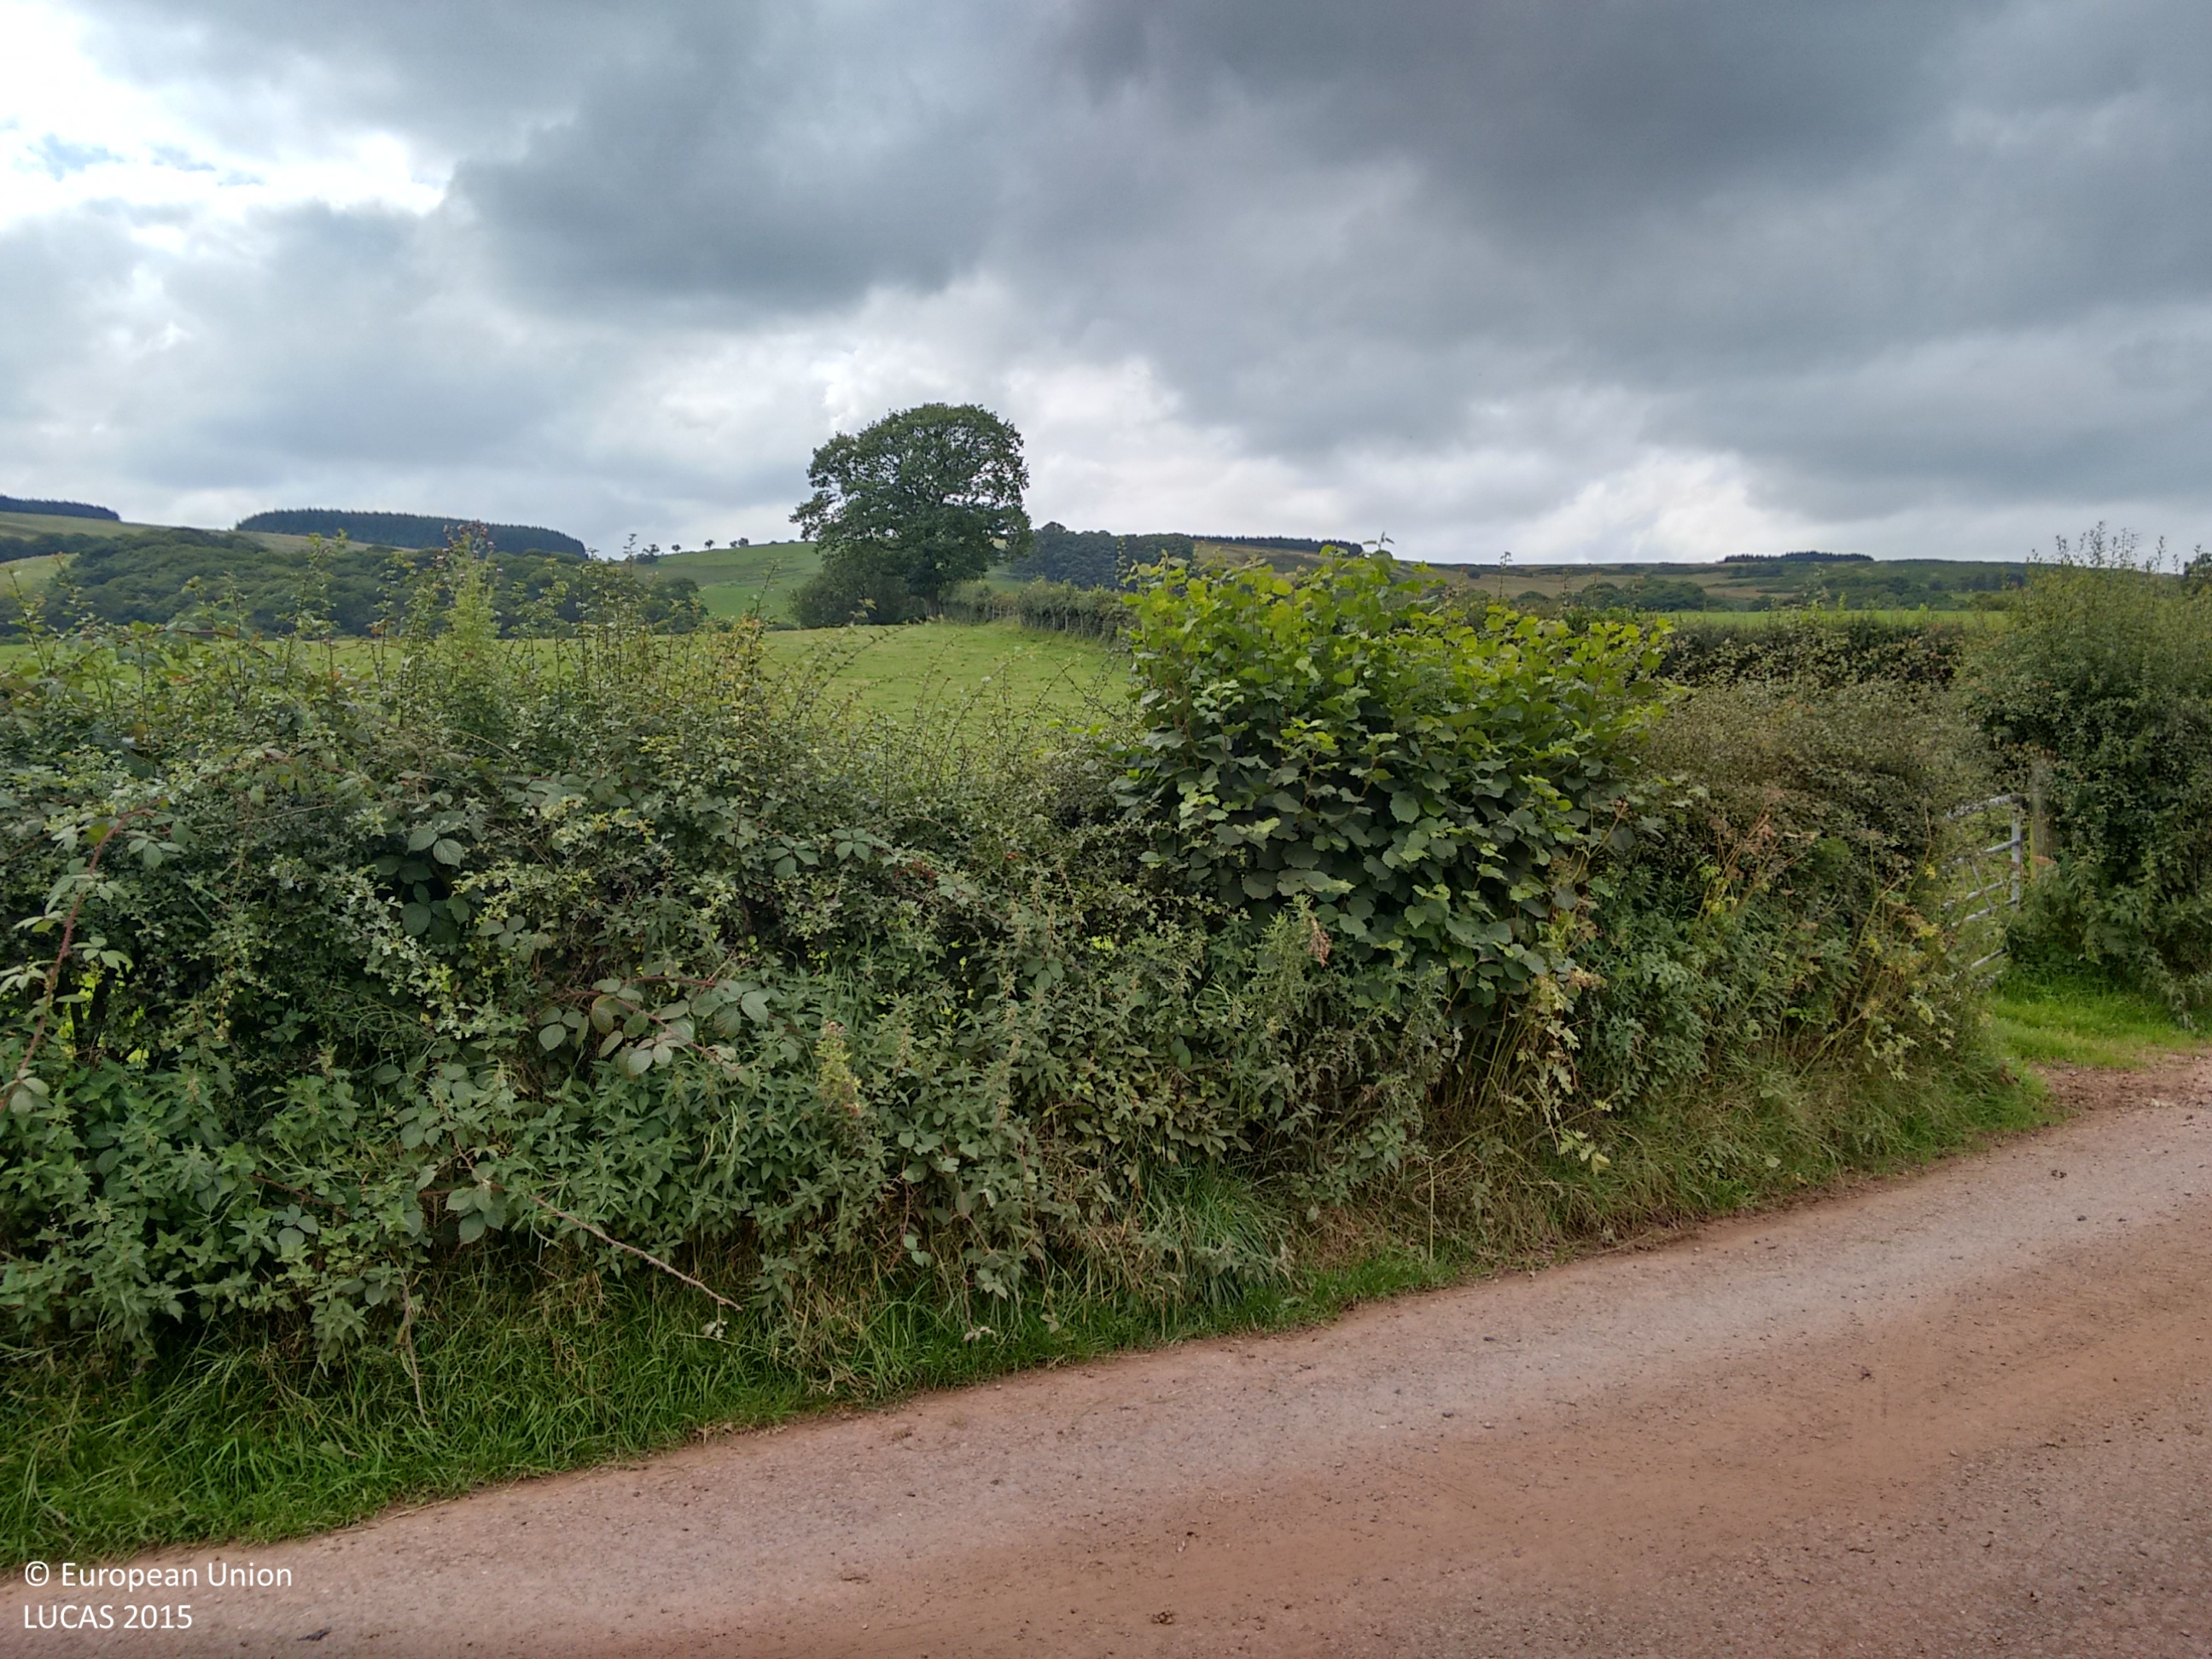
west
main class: Grassland
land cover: Grassland without tree/shrub cover
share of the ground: > 75 %
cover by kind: herbaceous plants 100 %
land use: Agriculture (excluding fallow land and kitchen gardens)
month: September
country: GB
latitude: 52.0623
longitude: -3.4592
